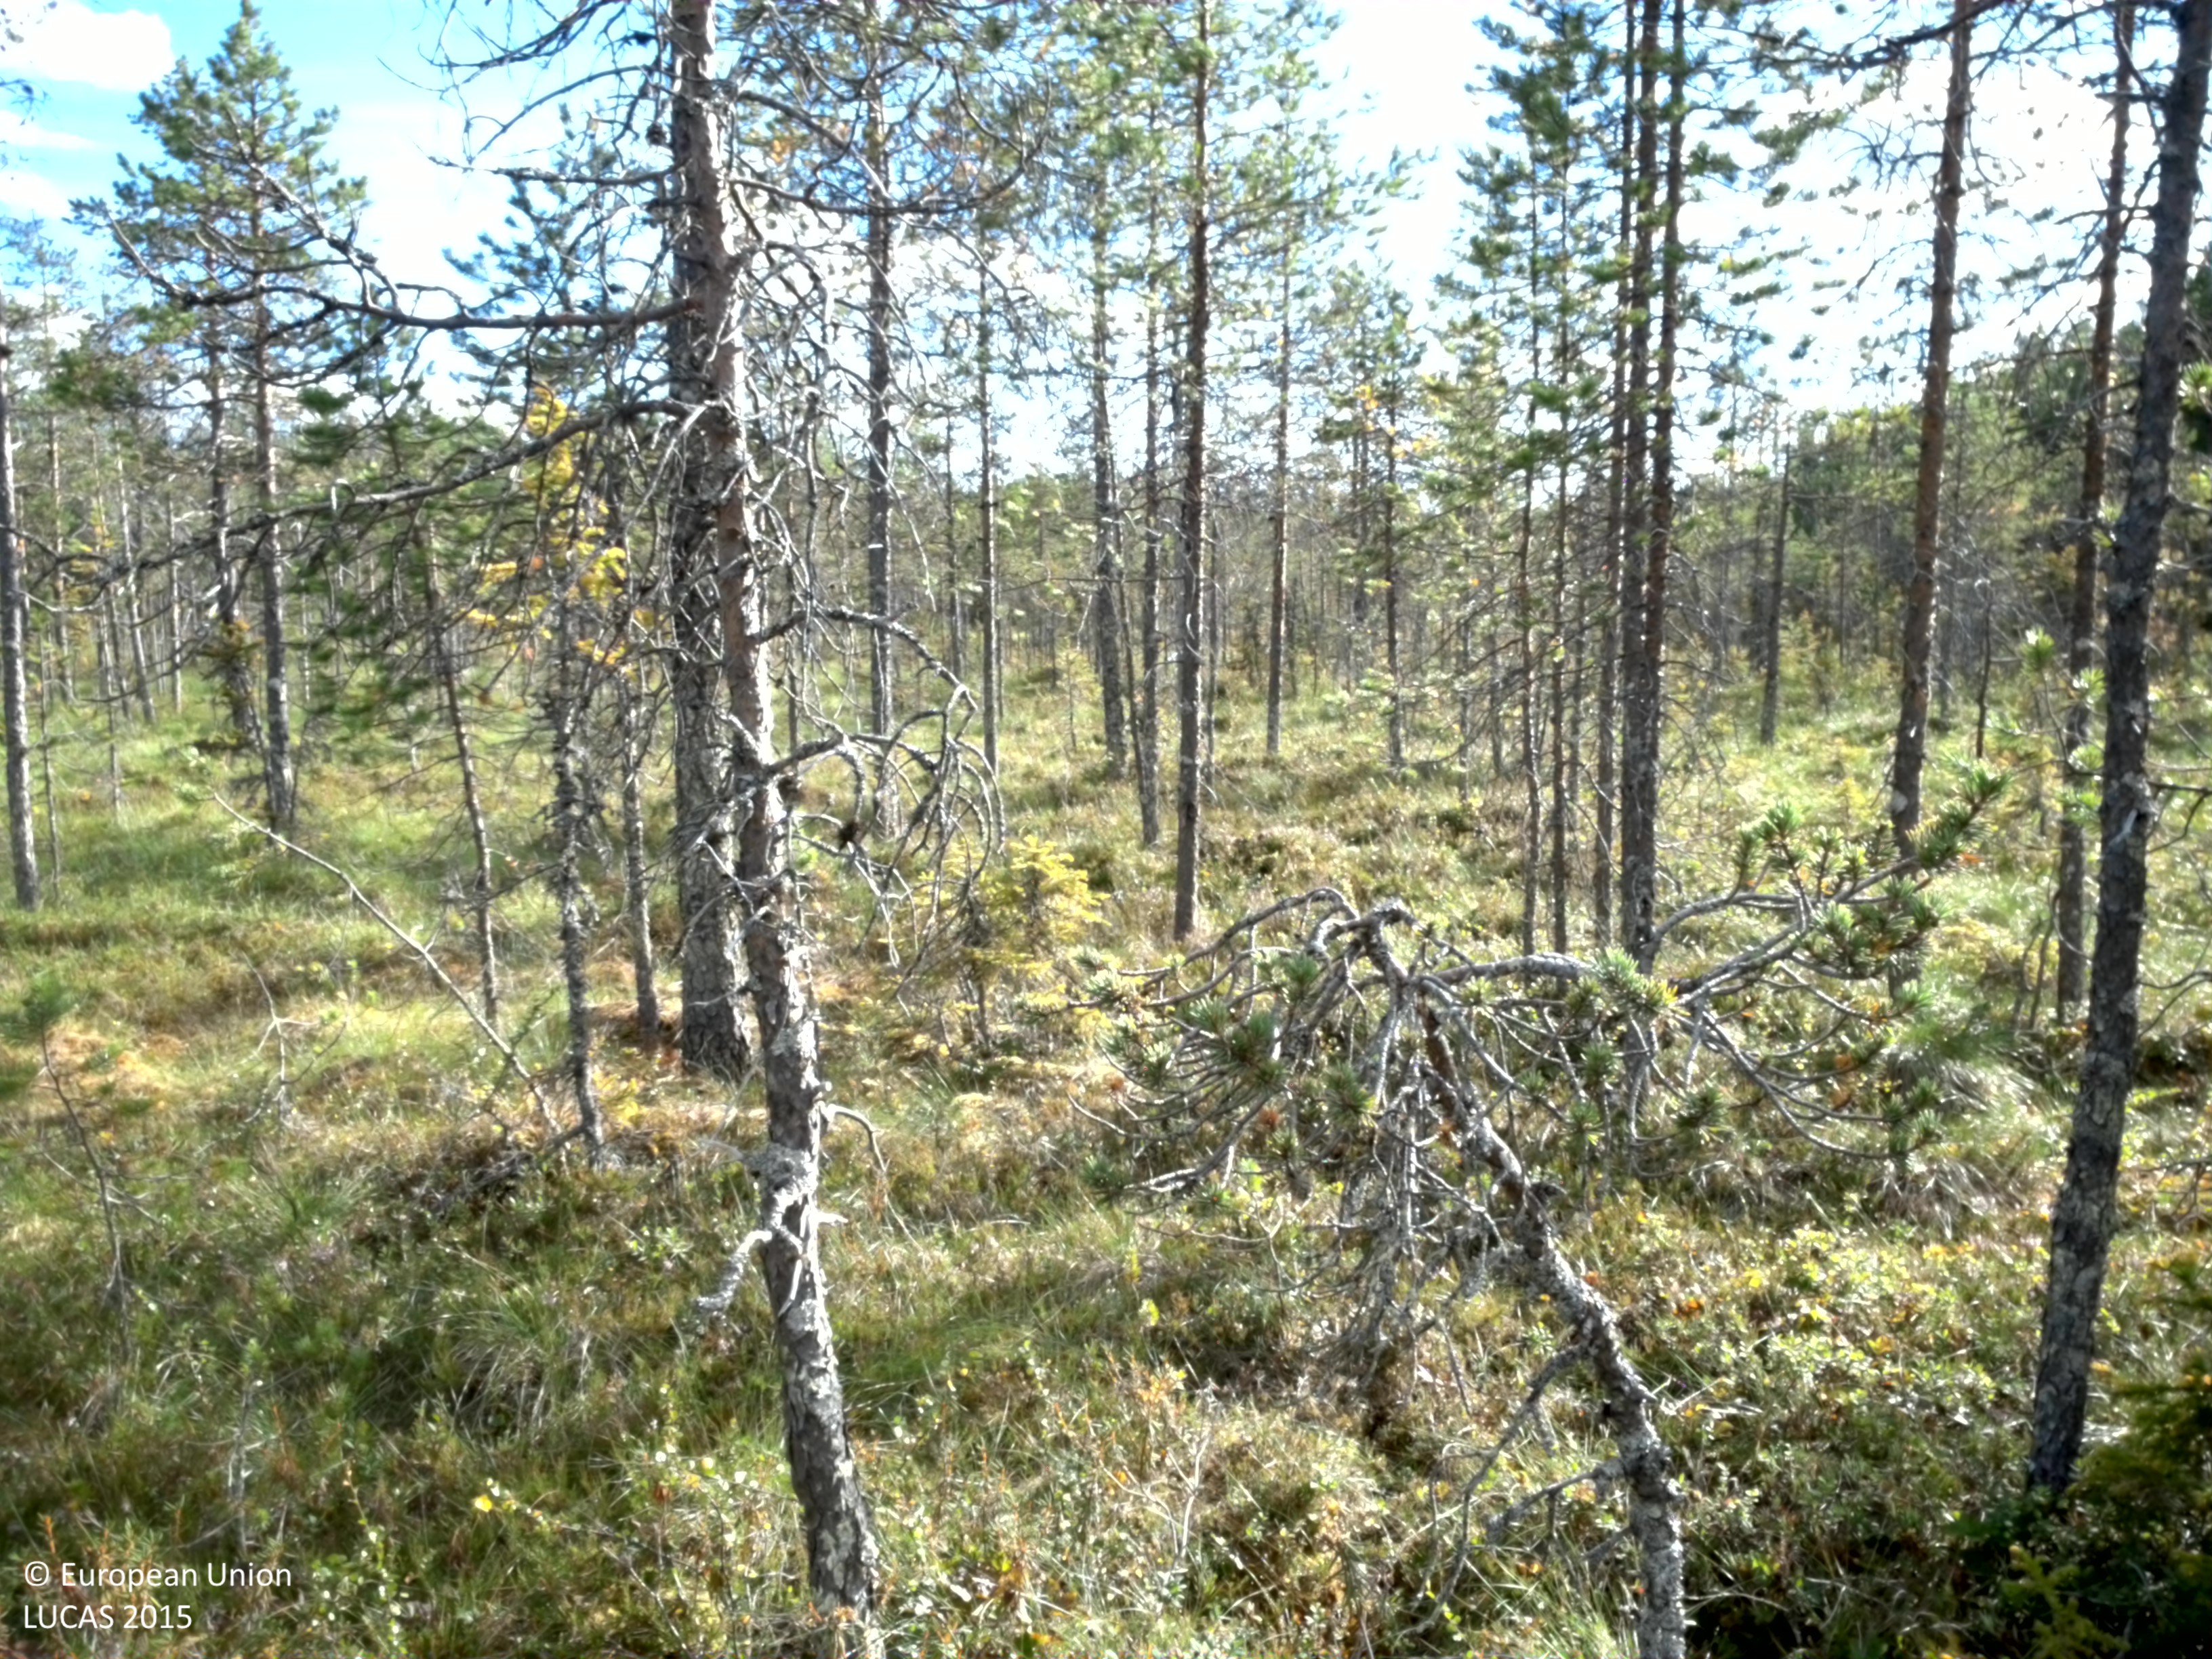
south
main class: Woodland
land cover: Pine dominated coniferous woodland
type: boreal forest
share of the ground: 10 - 25 %
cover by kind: shrubs 70 %, coniferous forest trees 15 %, herbaceous plants 10 %, lichens and mosses 5 %
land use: Semi-natural and natural areas not in use
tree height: > 5 m
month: August
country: SE
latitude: 66.1635
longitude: 22.6846
